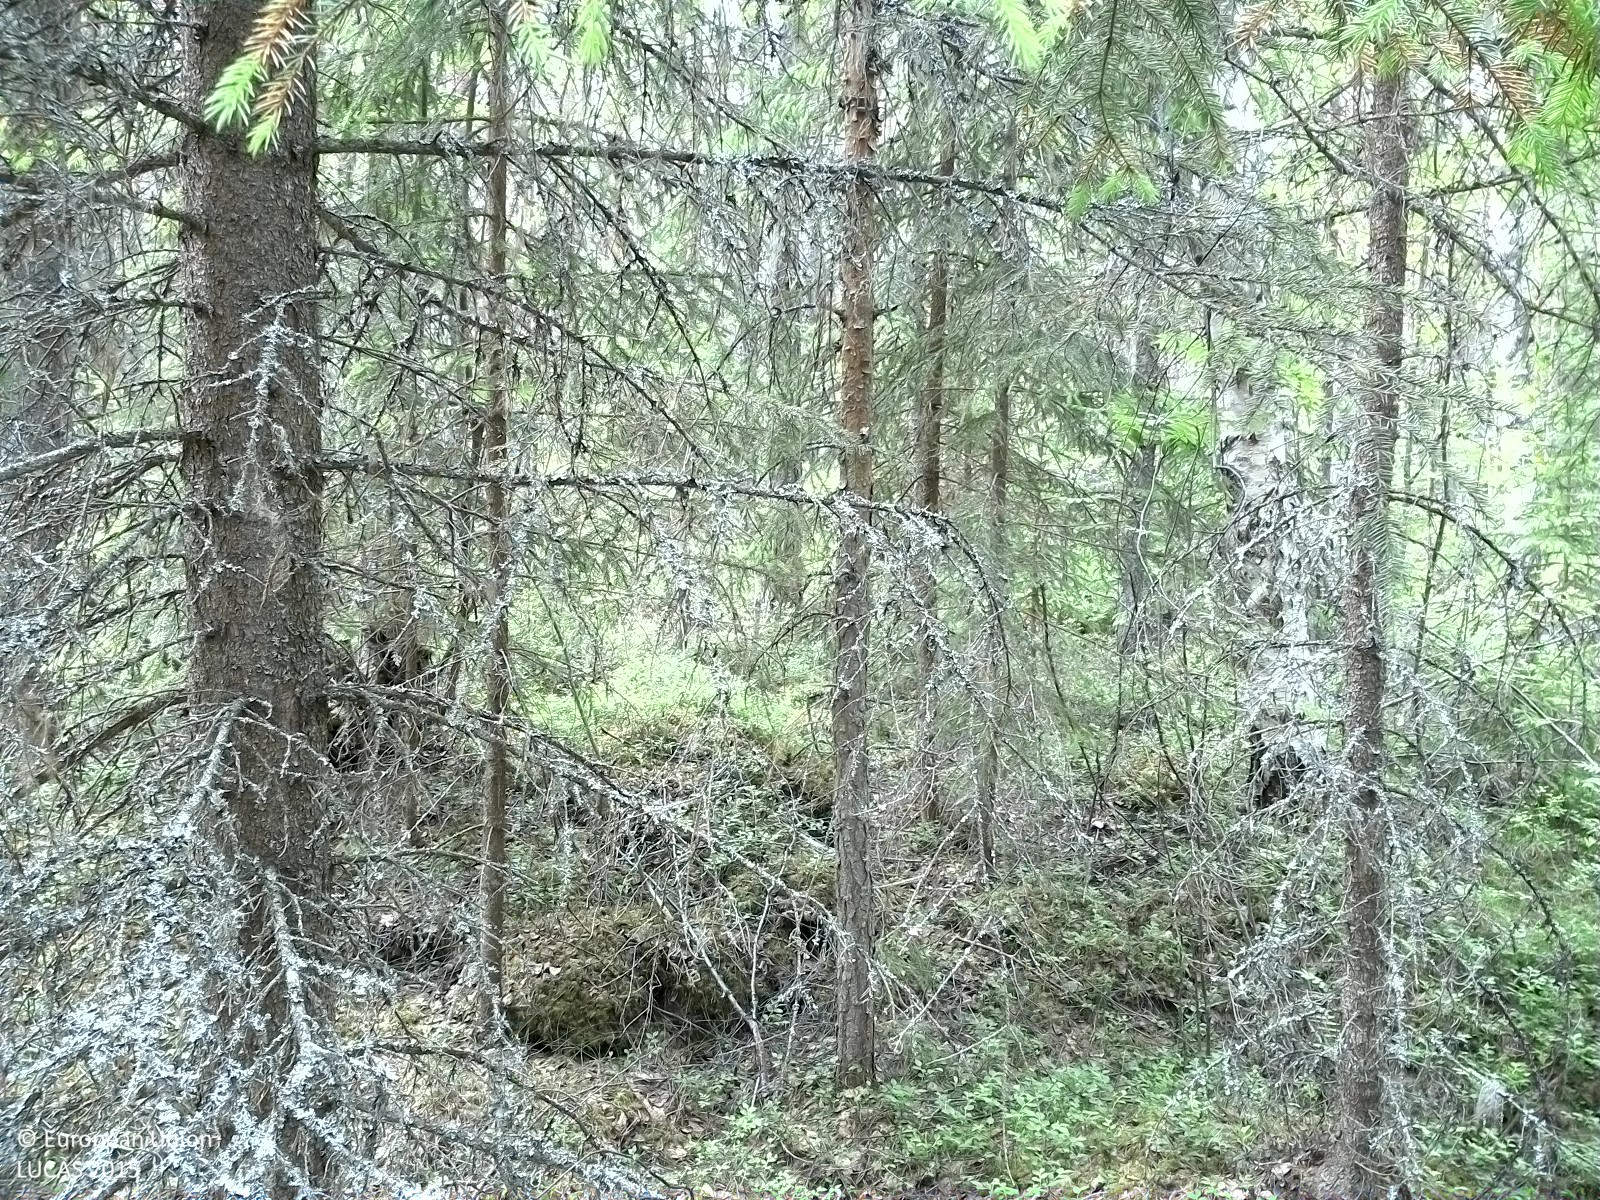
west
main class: Woodland
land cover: Pine dominated mixed woodland
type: boreal forest
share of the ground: 50 - 75 %
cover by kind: coniferous forest trees 35 %, shrubs 30 %, broadleaved forest trees 25 %, lichens and mosses 10 %
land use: Forestry
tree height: > 5 m
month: June
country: SE
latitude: 62.0491
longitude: 16.2351
